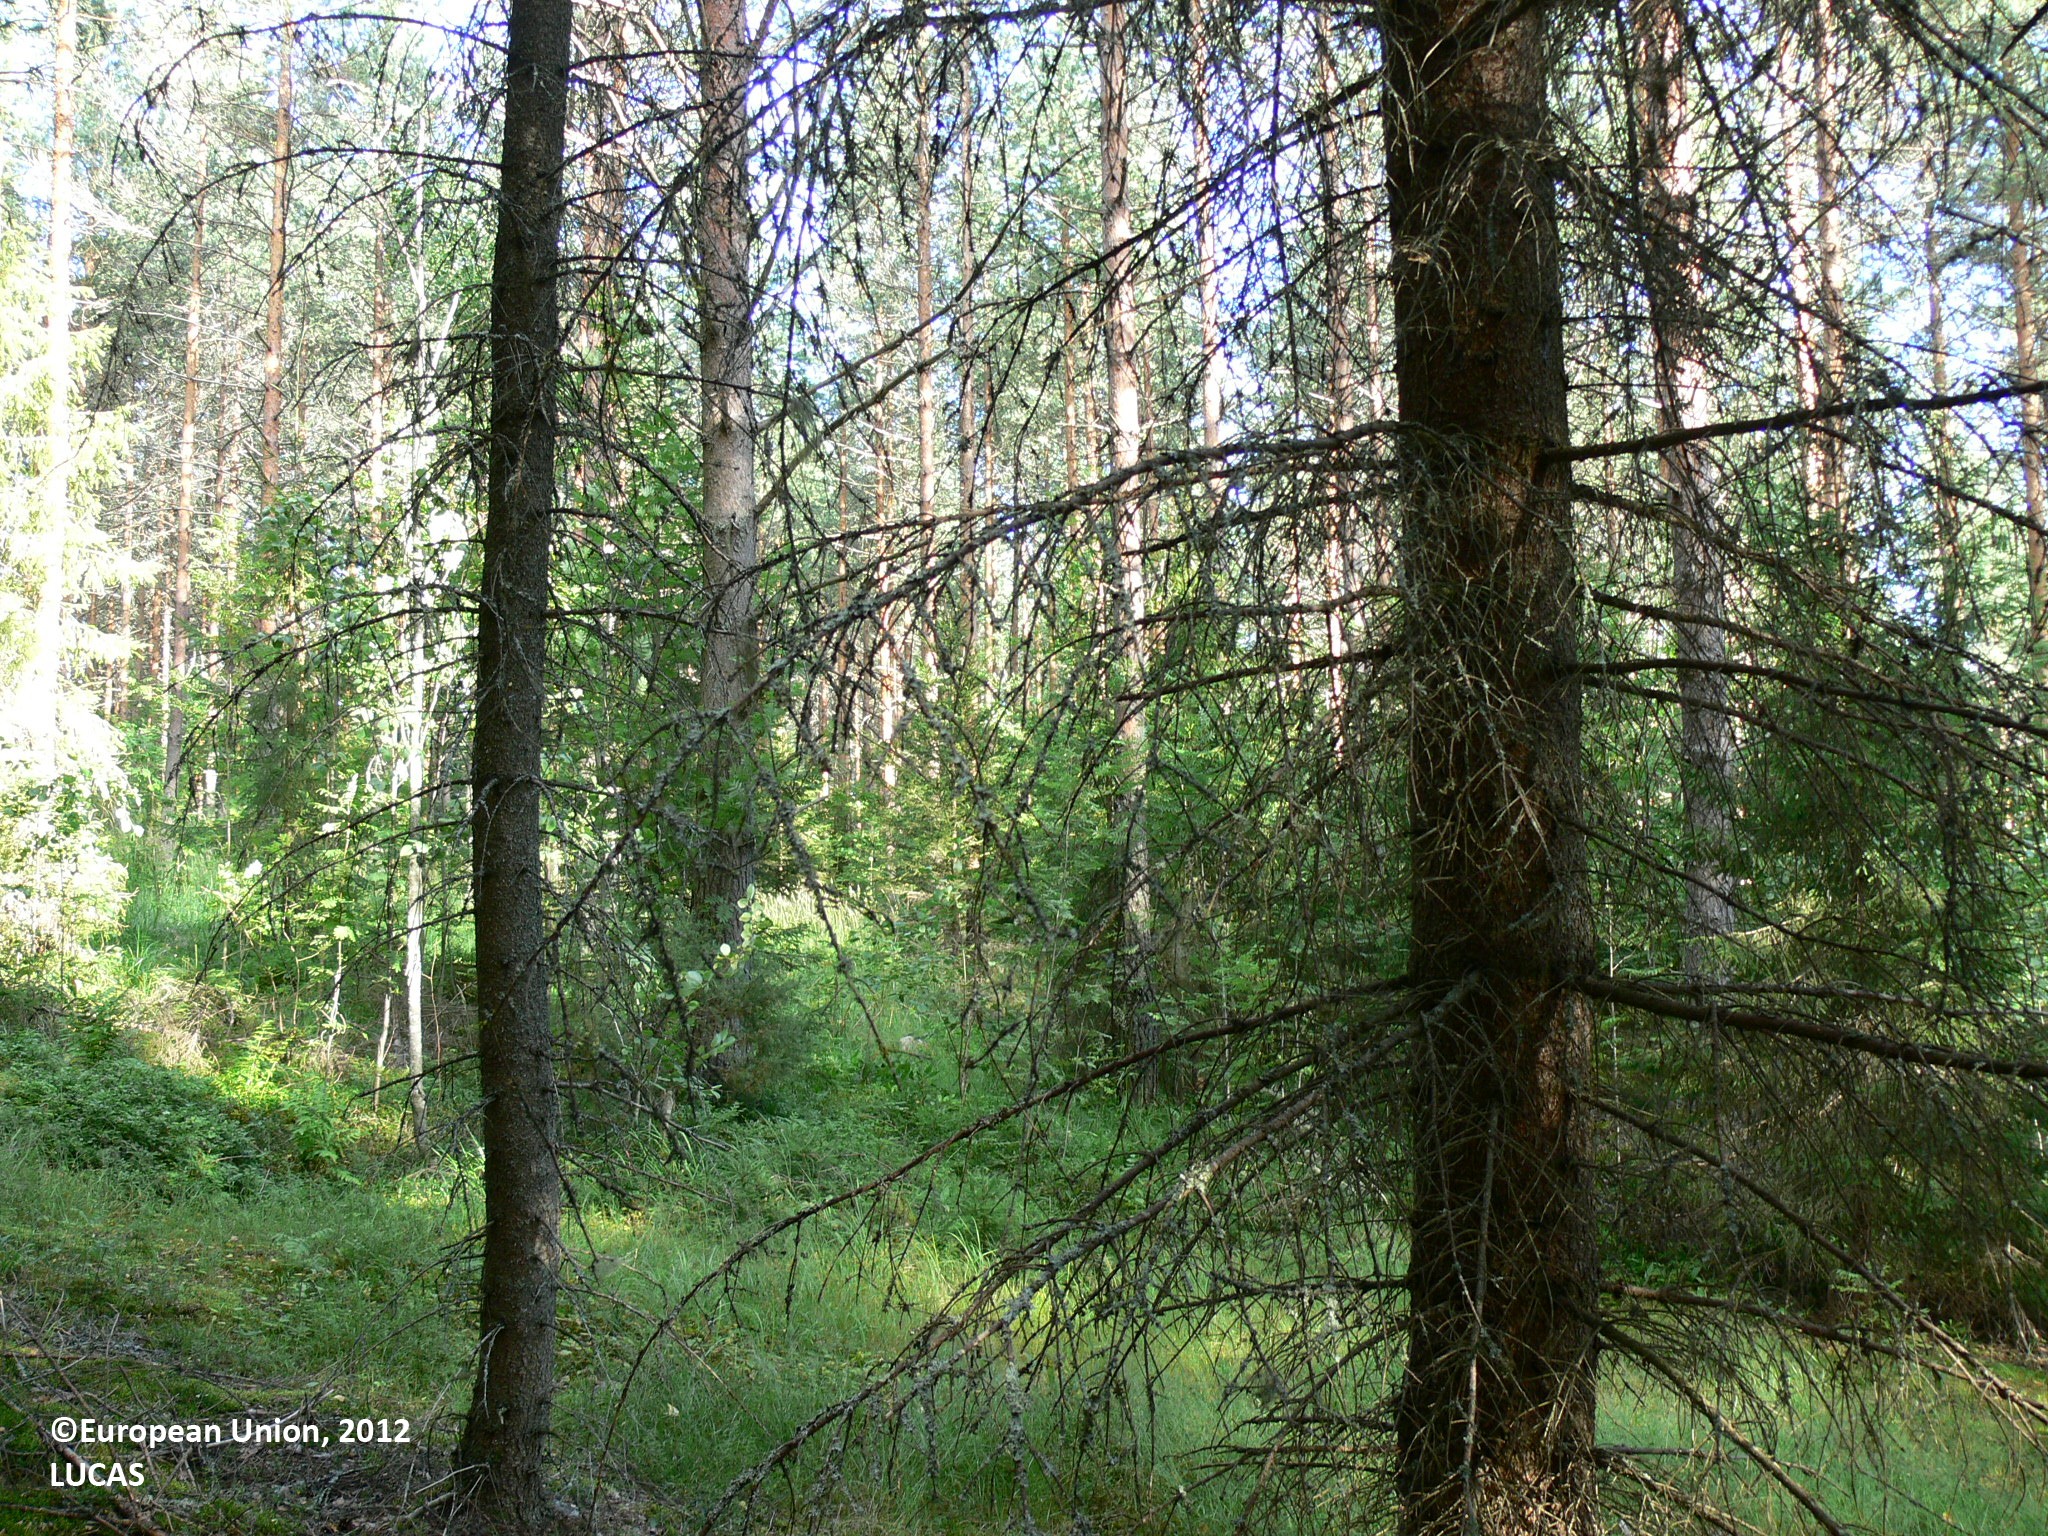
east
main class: Woodland
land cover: Spruce dominated coniferous woodland
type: boreal forest
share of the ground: > 75 %
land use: Forestry
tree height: > 5 m
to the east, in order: Spruce dominated coniferous woodland; Pine dominated coniferous woodland; Other coniferous woodland; Spruce dominated mixed woodland; Spruce dominated coniferous woodland; Other mixed woodland
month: August
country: FI
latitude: 62.0271
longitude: 29.2103
